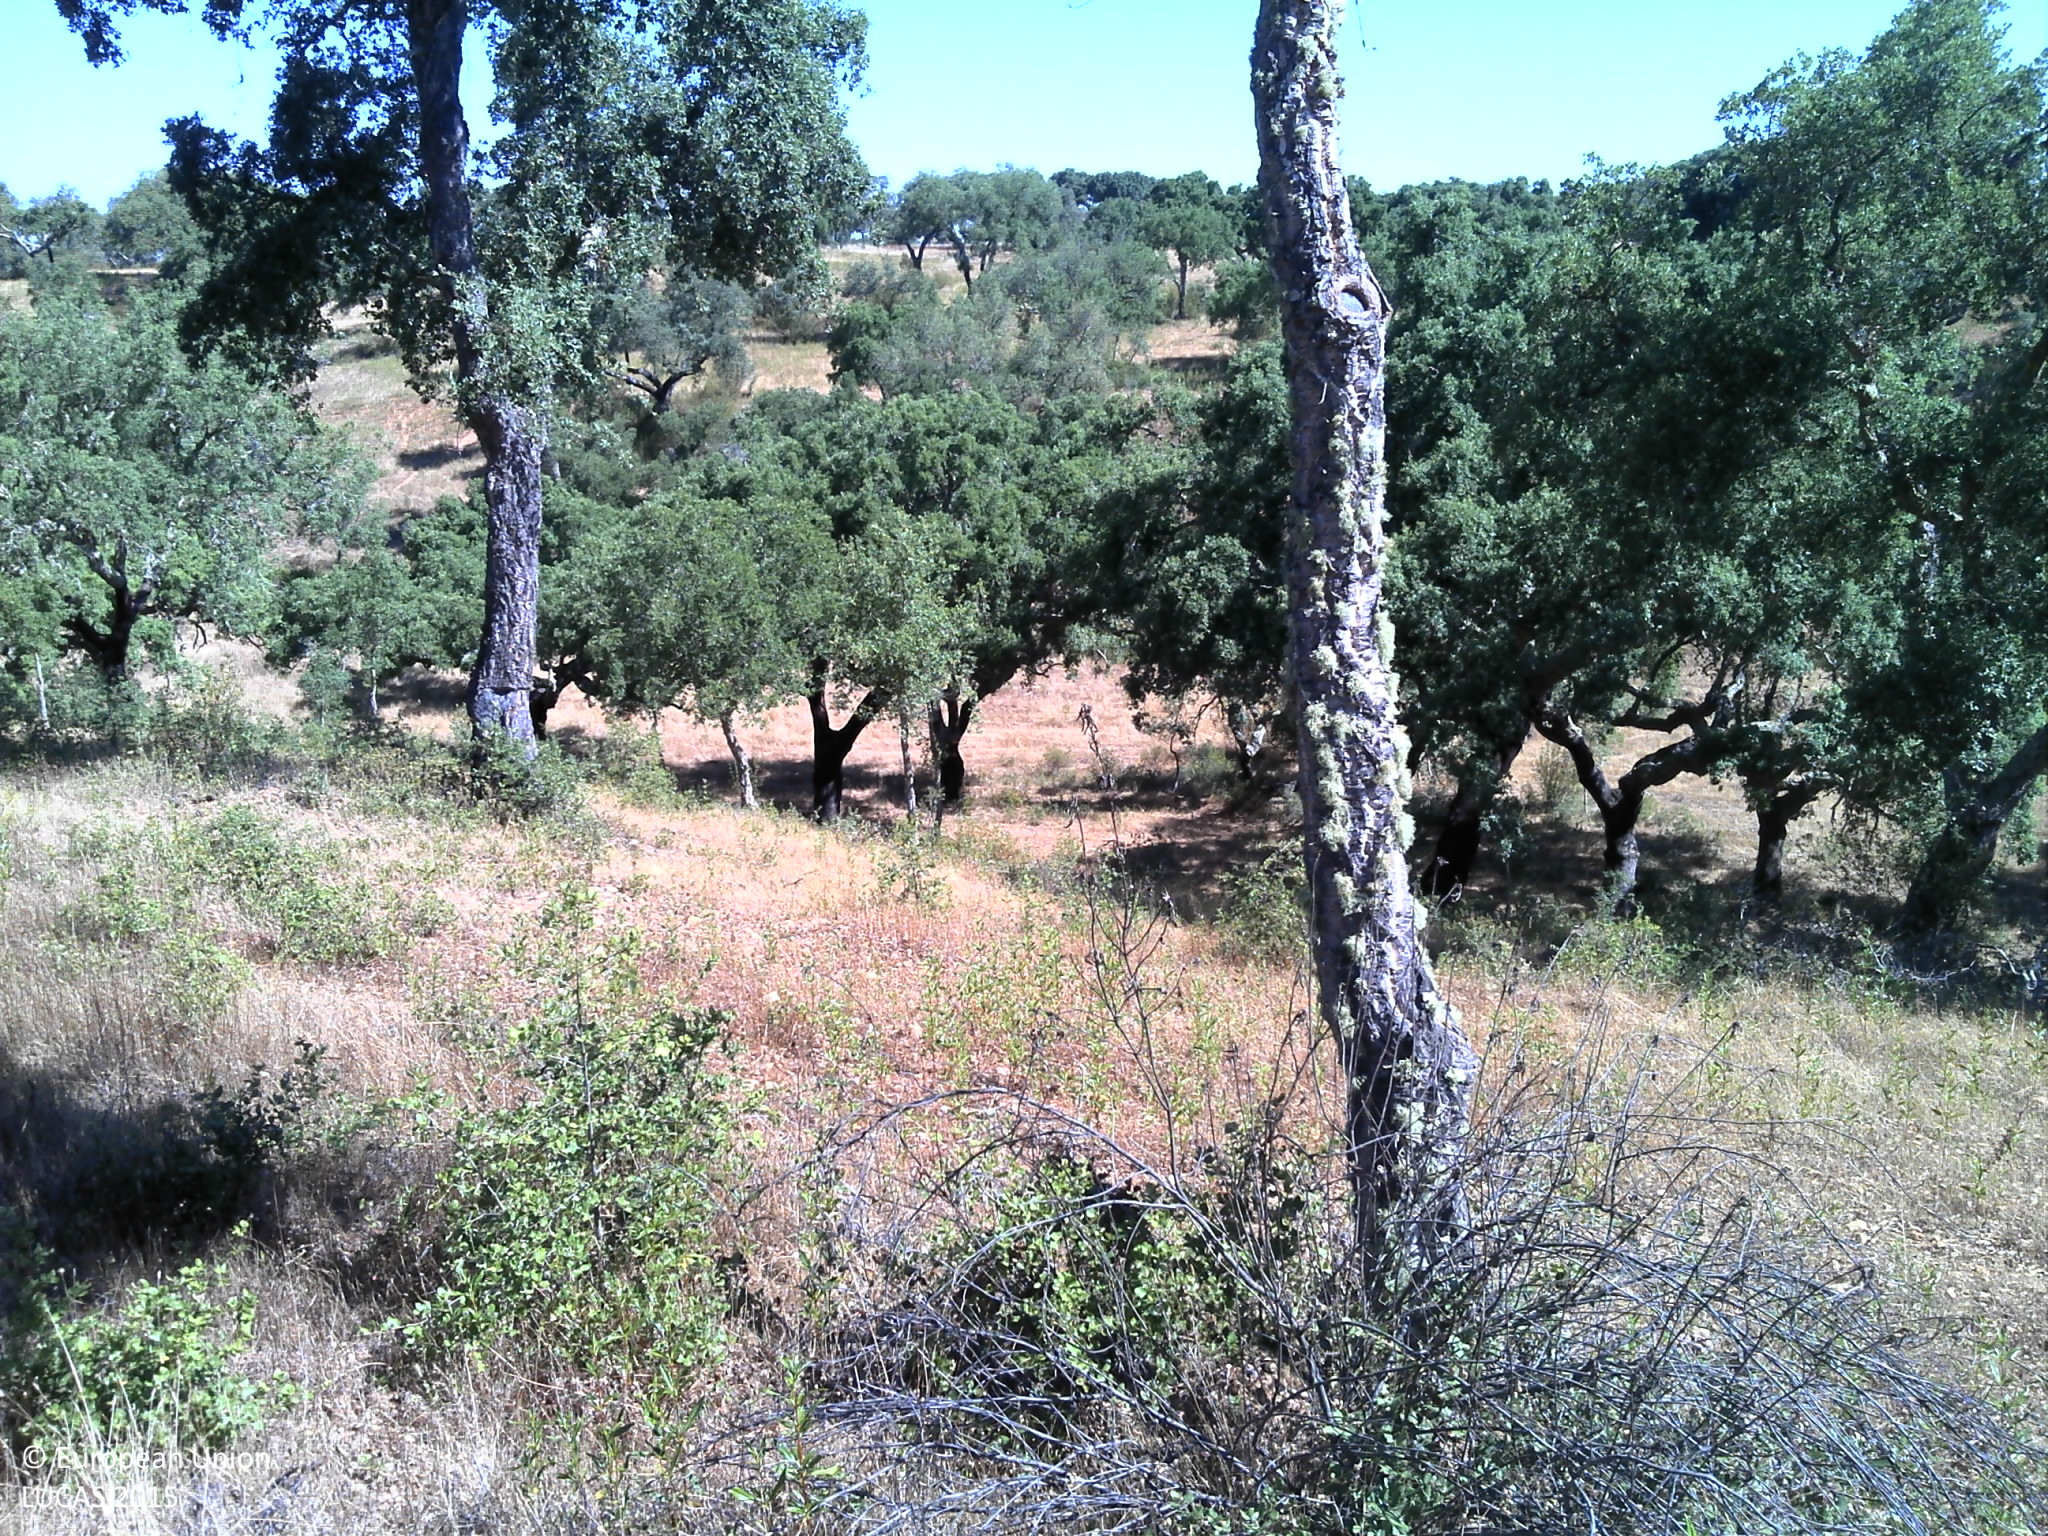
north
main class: Woodland
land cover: Broadleaved woodland
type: broadleaved evergreen forest
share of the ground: 25 - 50 %
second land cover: Grassland without tree/shrub cover
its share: 25 - 50 %
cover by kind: broadleaved forest trees 40 %, herbaceous plants 40 %, consolidated bare surface 20 %
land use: Forestry
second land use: Agriculture (excluding fallow land and kitchen gardens)
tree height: > 5 m
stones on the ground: < 10 %
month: June
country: PT
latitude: 37.8019
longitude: -8.5179
